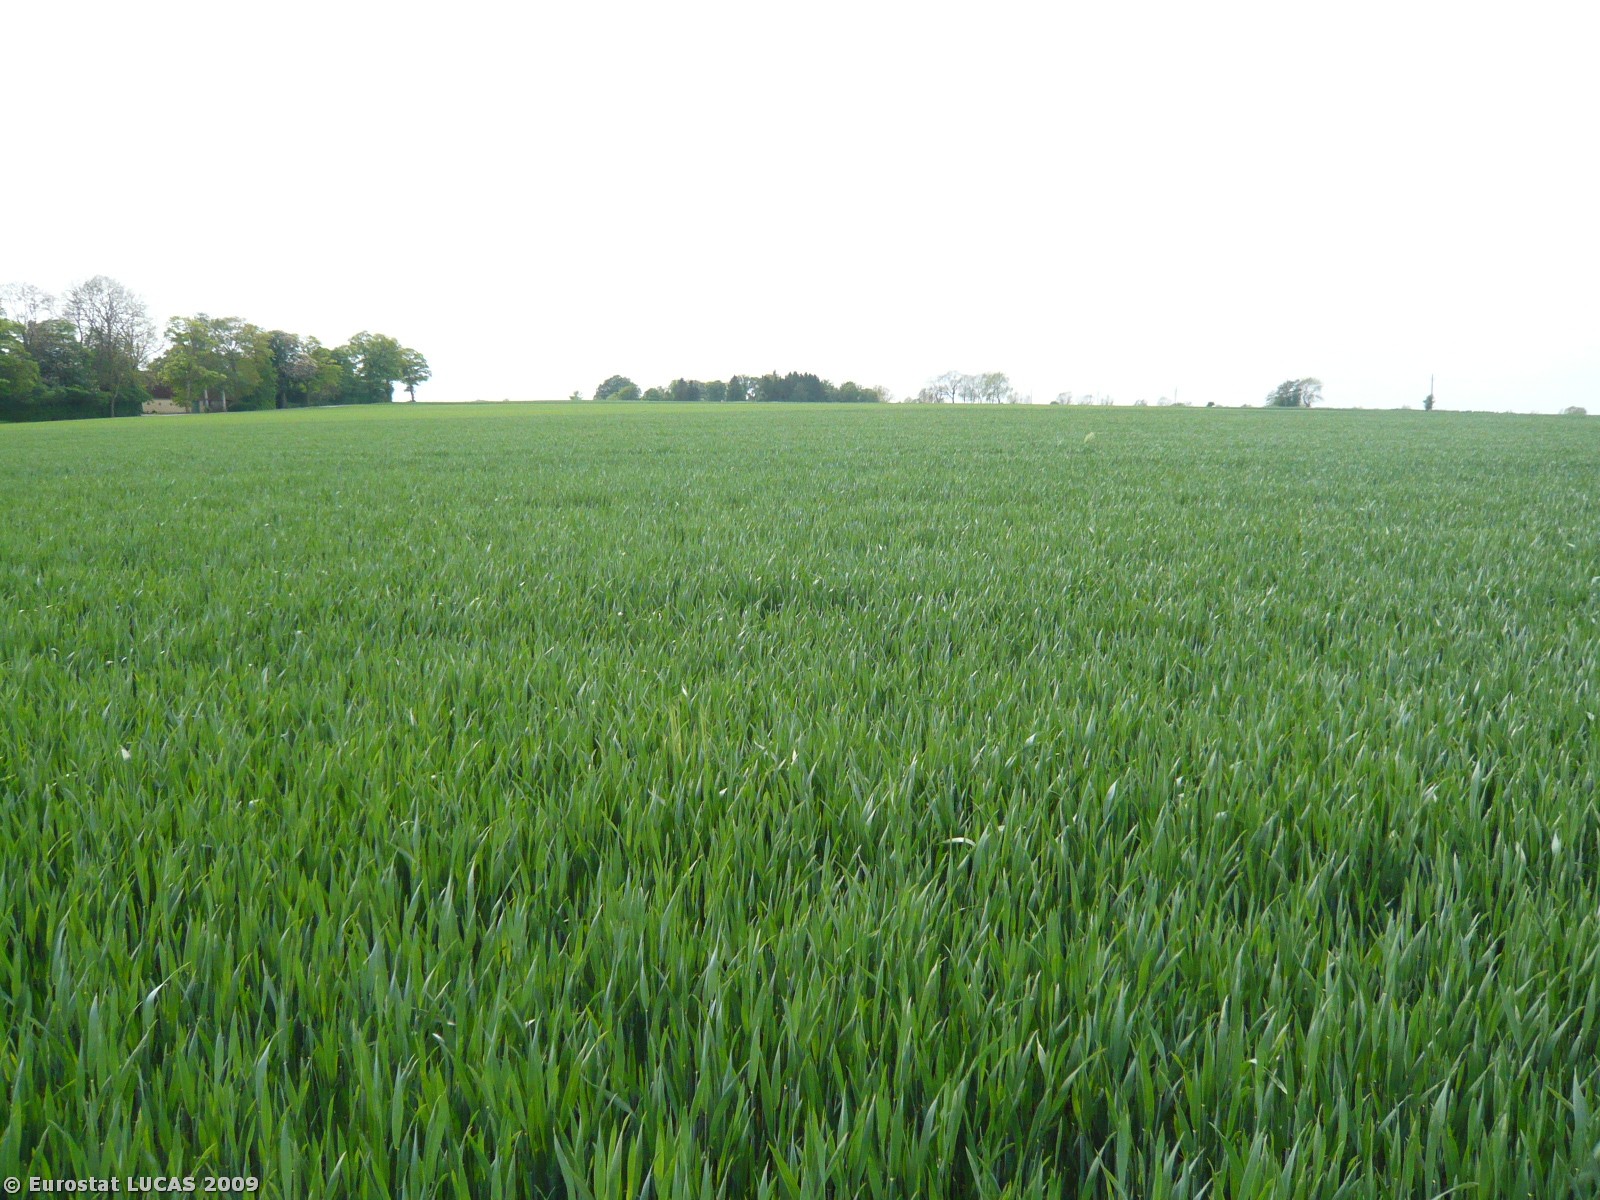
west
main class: Cropland
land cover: Common wheat
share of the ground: > 75 %
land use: Agriculture (excluding fallow land and kitchen gardens)
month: May
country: DK
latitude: 55.3834
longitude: 11.8453
